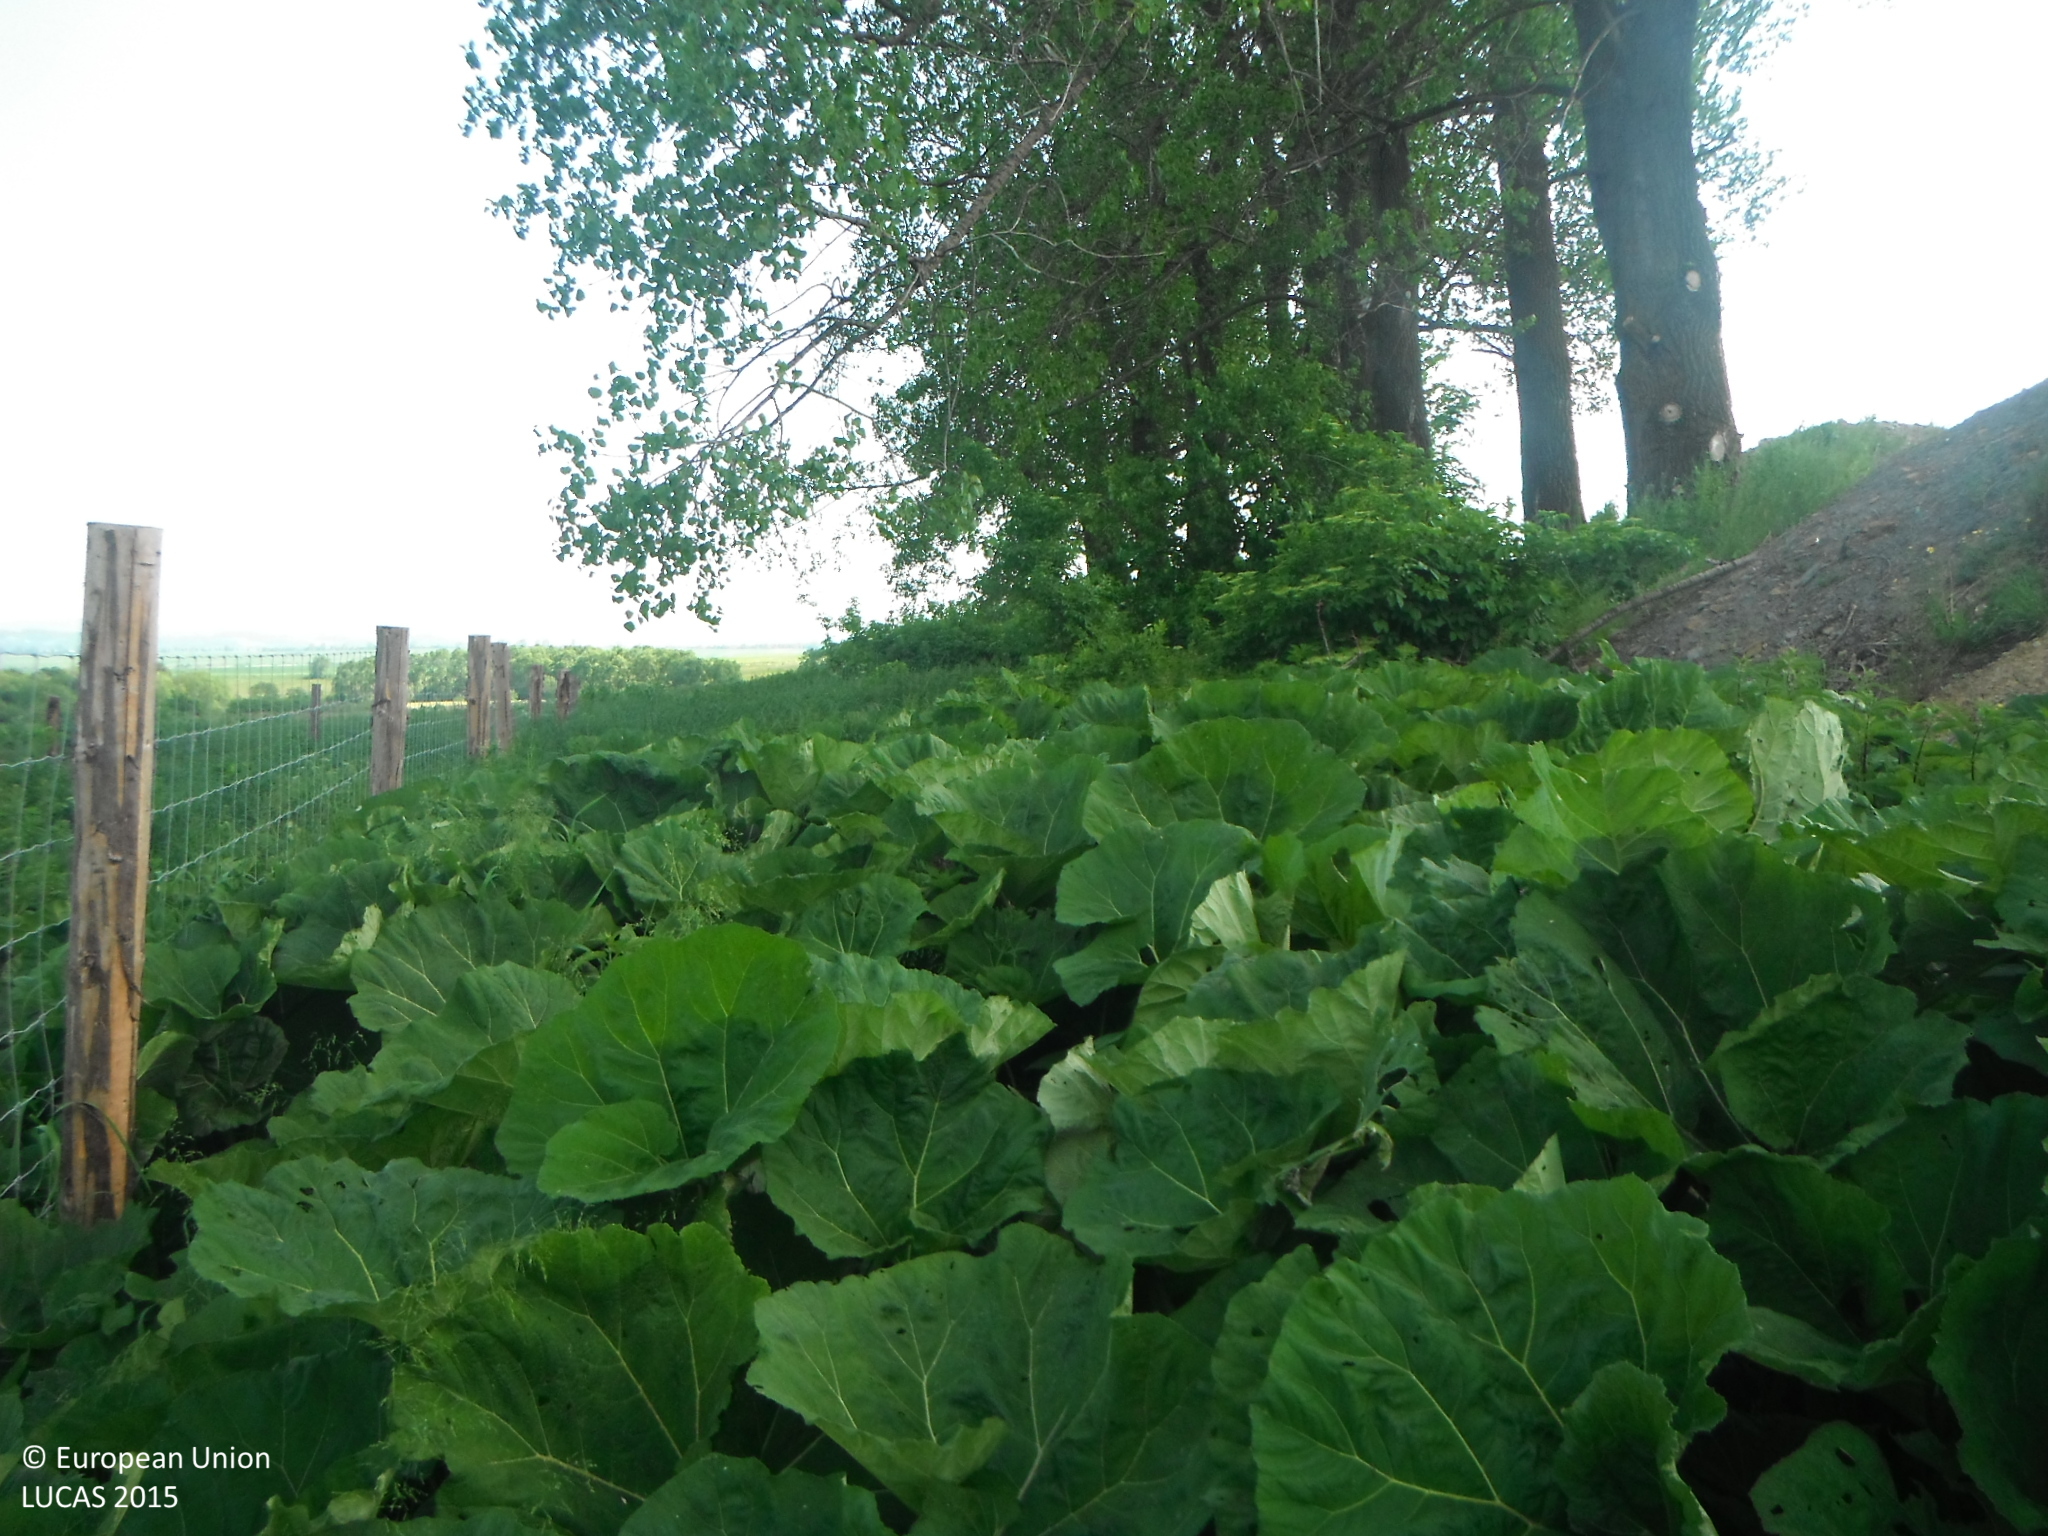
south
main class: Grassland
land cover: Spontaneously vegetated surfaces
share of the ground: > 75 %
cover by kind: herbaceous plants 100 %
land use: Fallow land
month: June
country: SK
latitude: 49.2354
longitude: 20.4045
